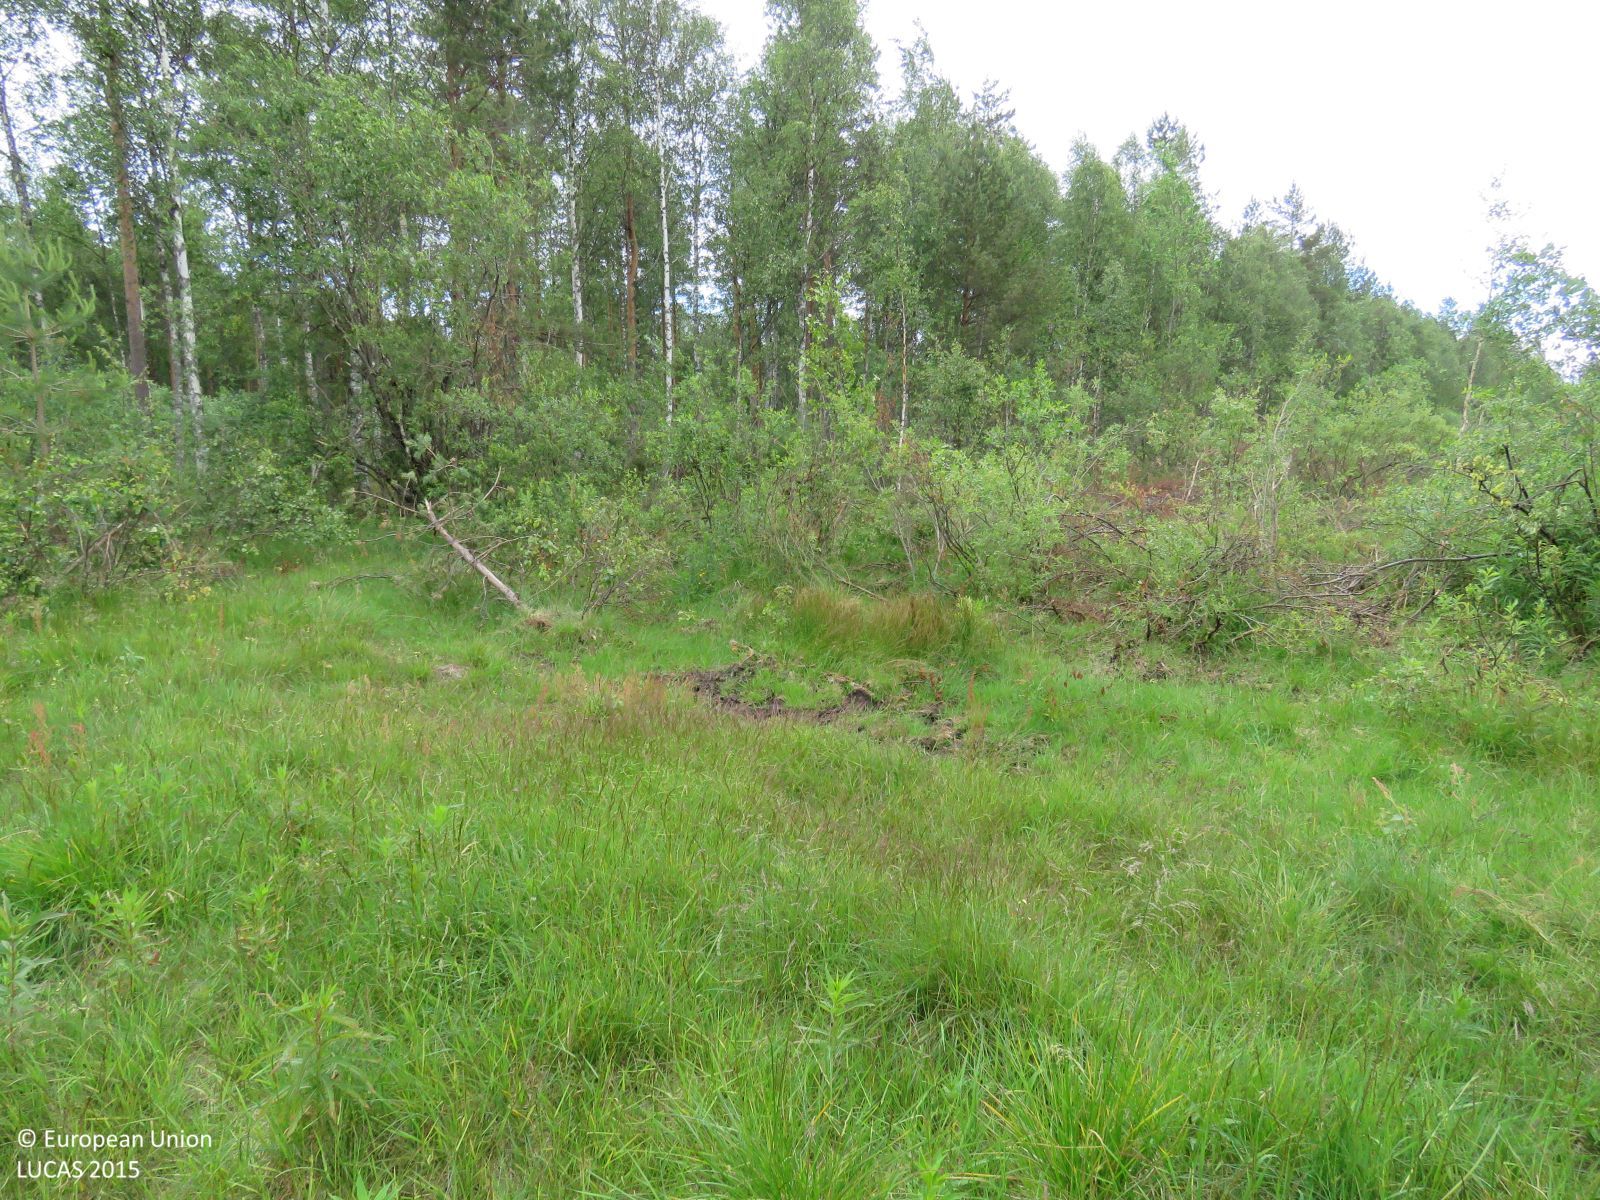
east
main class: Shrubland
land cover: Shrubland with sparse tree cover
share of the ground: 50 - 75 %
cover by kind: herbaceous plants 55 %, shrubs 40 %, broadleaved forest trees 5 %
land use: Semi-natural and natural areas not in use
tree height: < 5 m
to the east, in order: Shrubland with sparse tree cover; Ditches and canals; Other mixed woodland; Ditches and canals; Shrubland with sparse tree cover; Ditches and canals; Grassland without tree/shrub cover; Ditches and canals; Abandoned hedges; Grassland with sparse tree/shrub cover; Abandoned hedges; Ditches and canals; Other mixed woodland; Abandoned hedges; Ditches and canals; Other mixed woodland; Ditches and canals; Pine dominated mixed woodland; Ditches and canals; Pine dominated mixed woodland
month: July
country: FI
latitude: 64.4516
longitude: 26.6832
